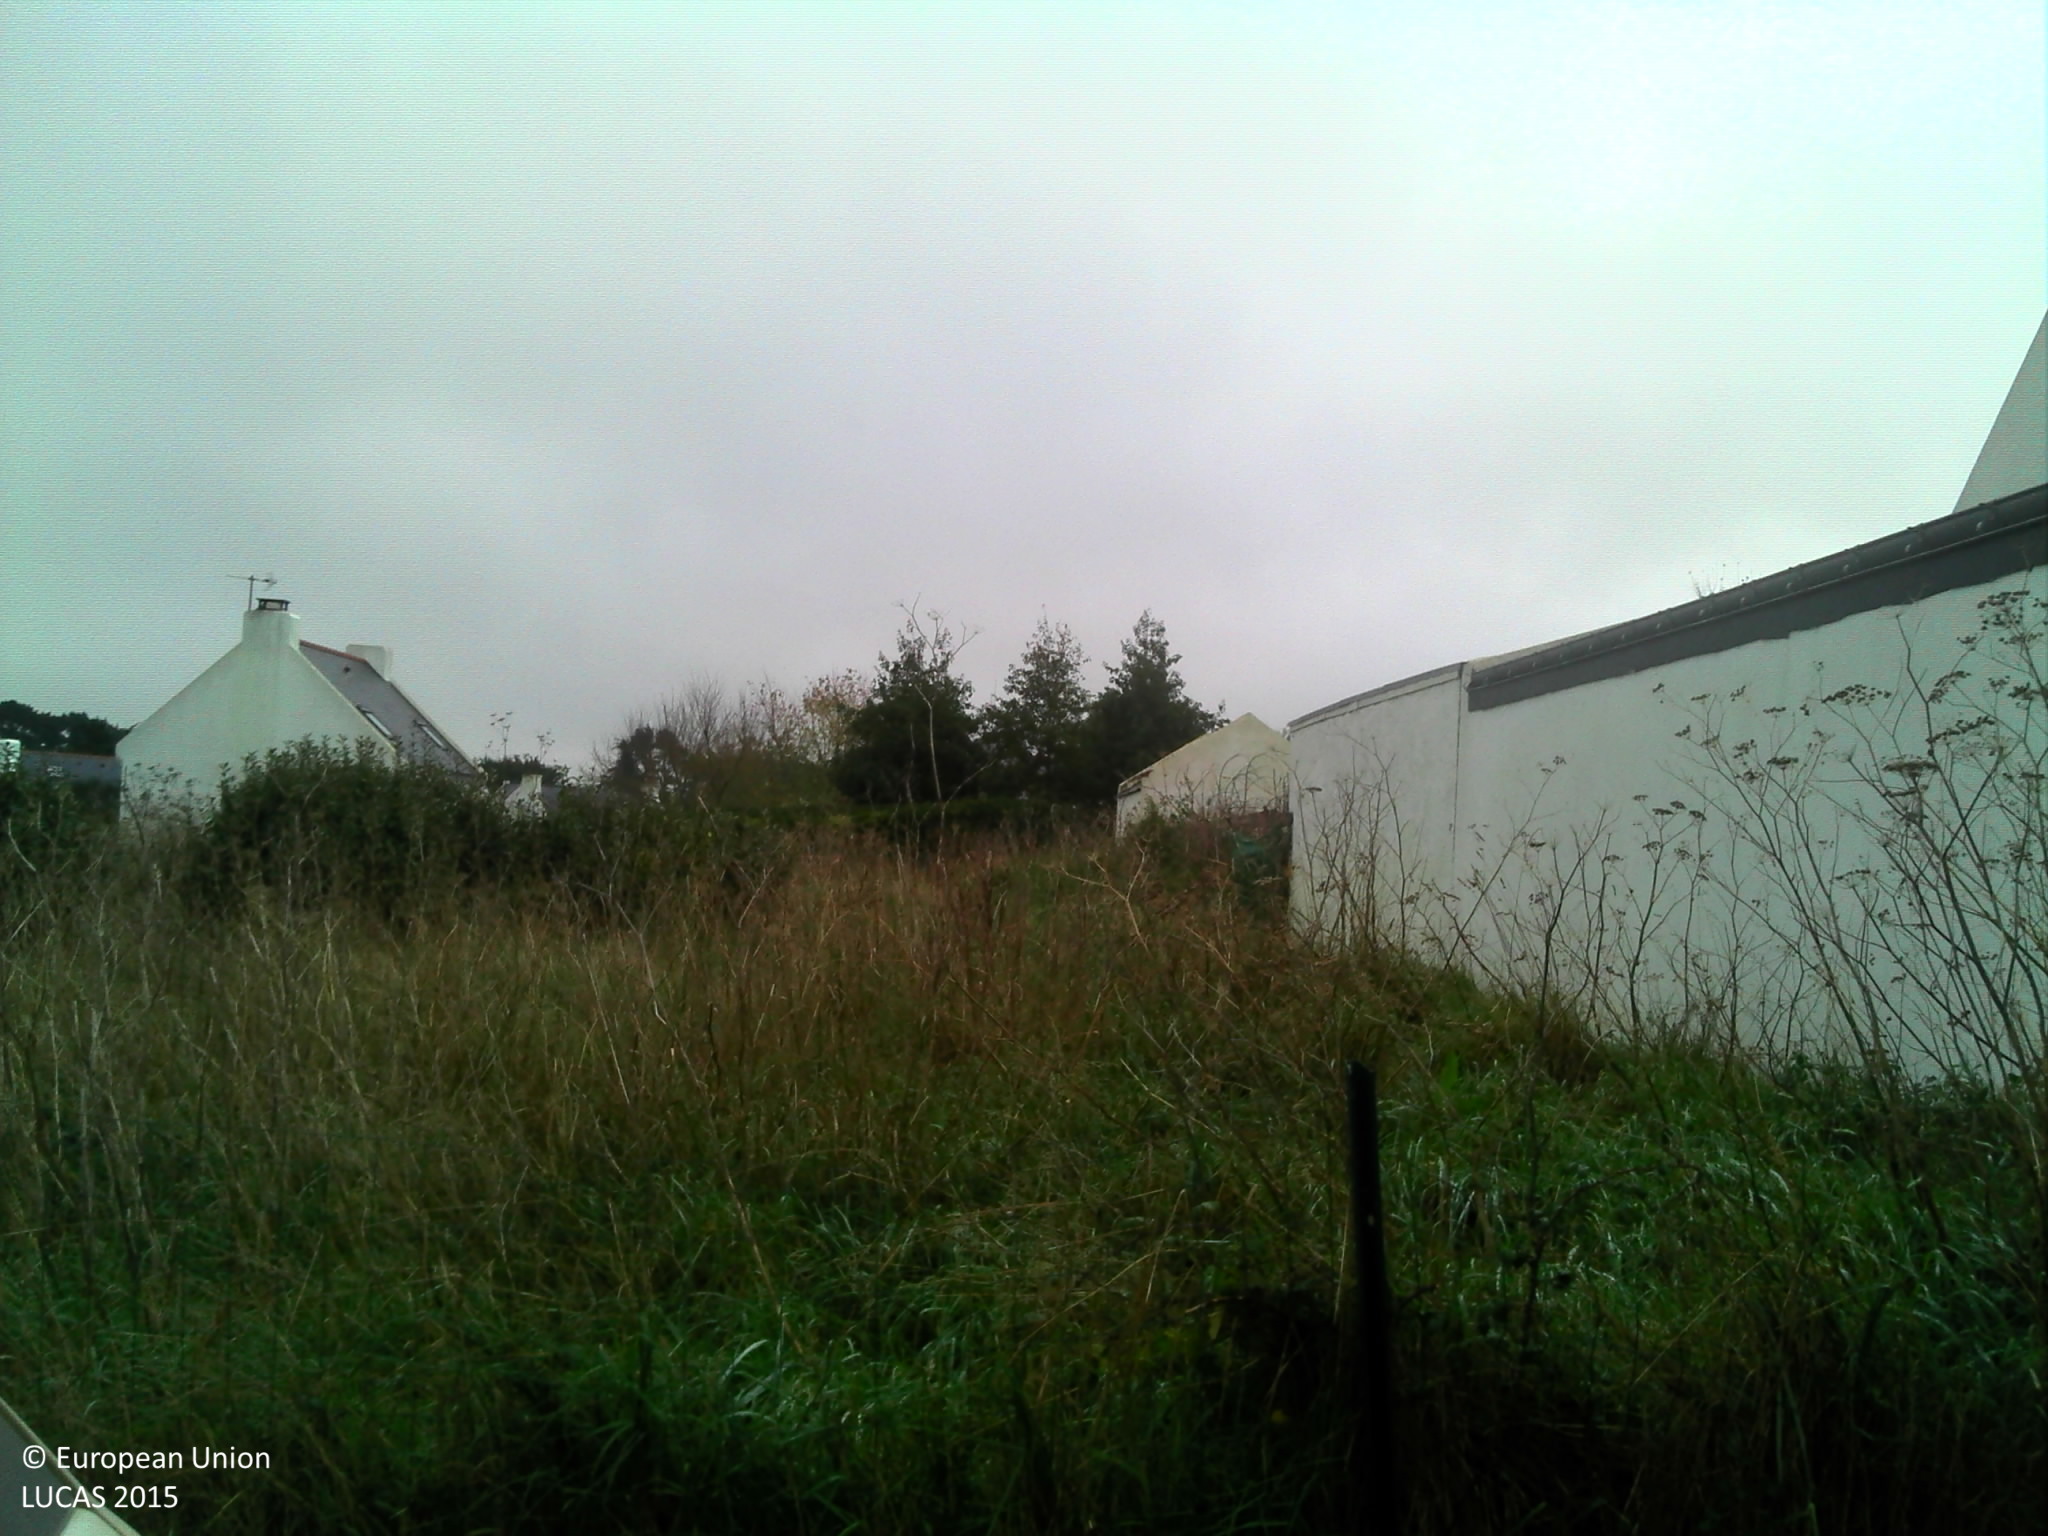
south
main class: Grassland
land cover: Grassland without tree/shrub cover
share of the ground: > 75 %
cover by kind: herbaceous plants 100 %
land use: Residential
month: November
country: FR
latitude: 47.3397
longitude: -3.1563
